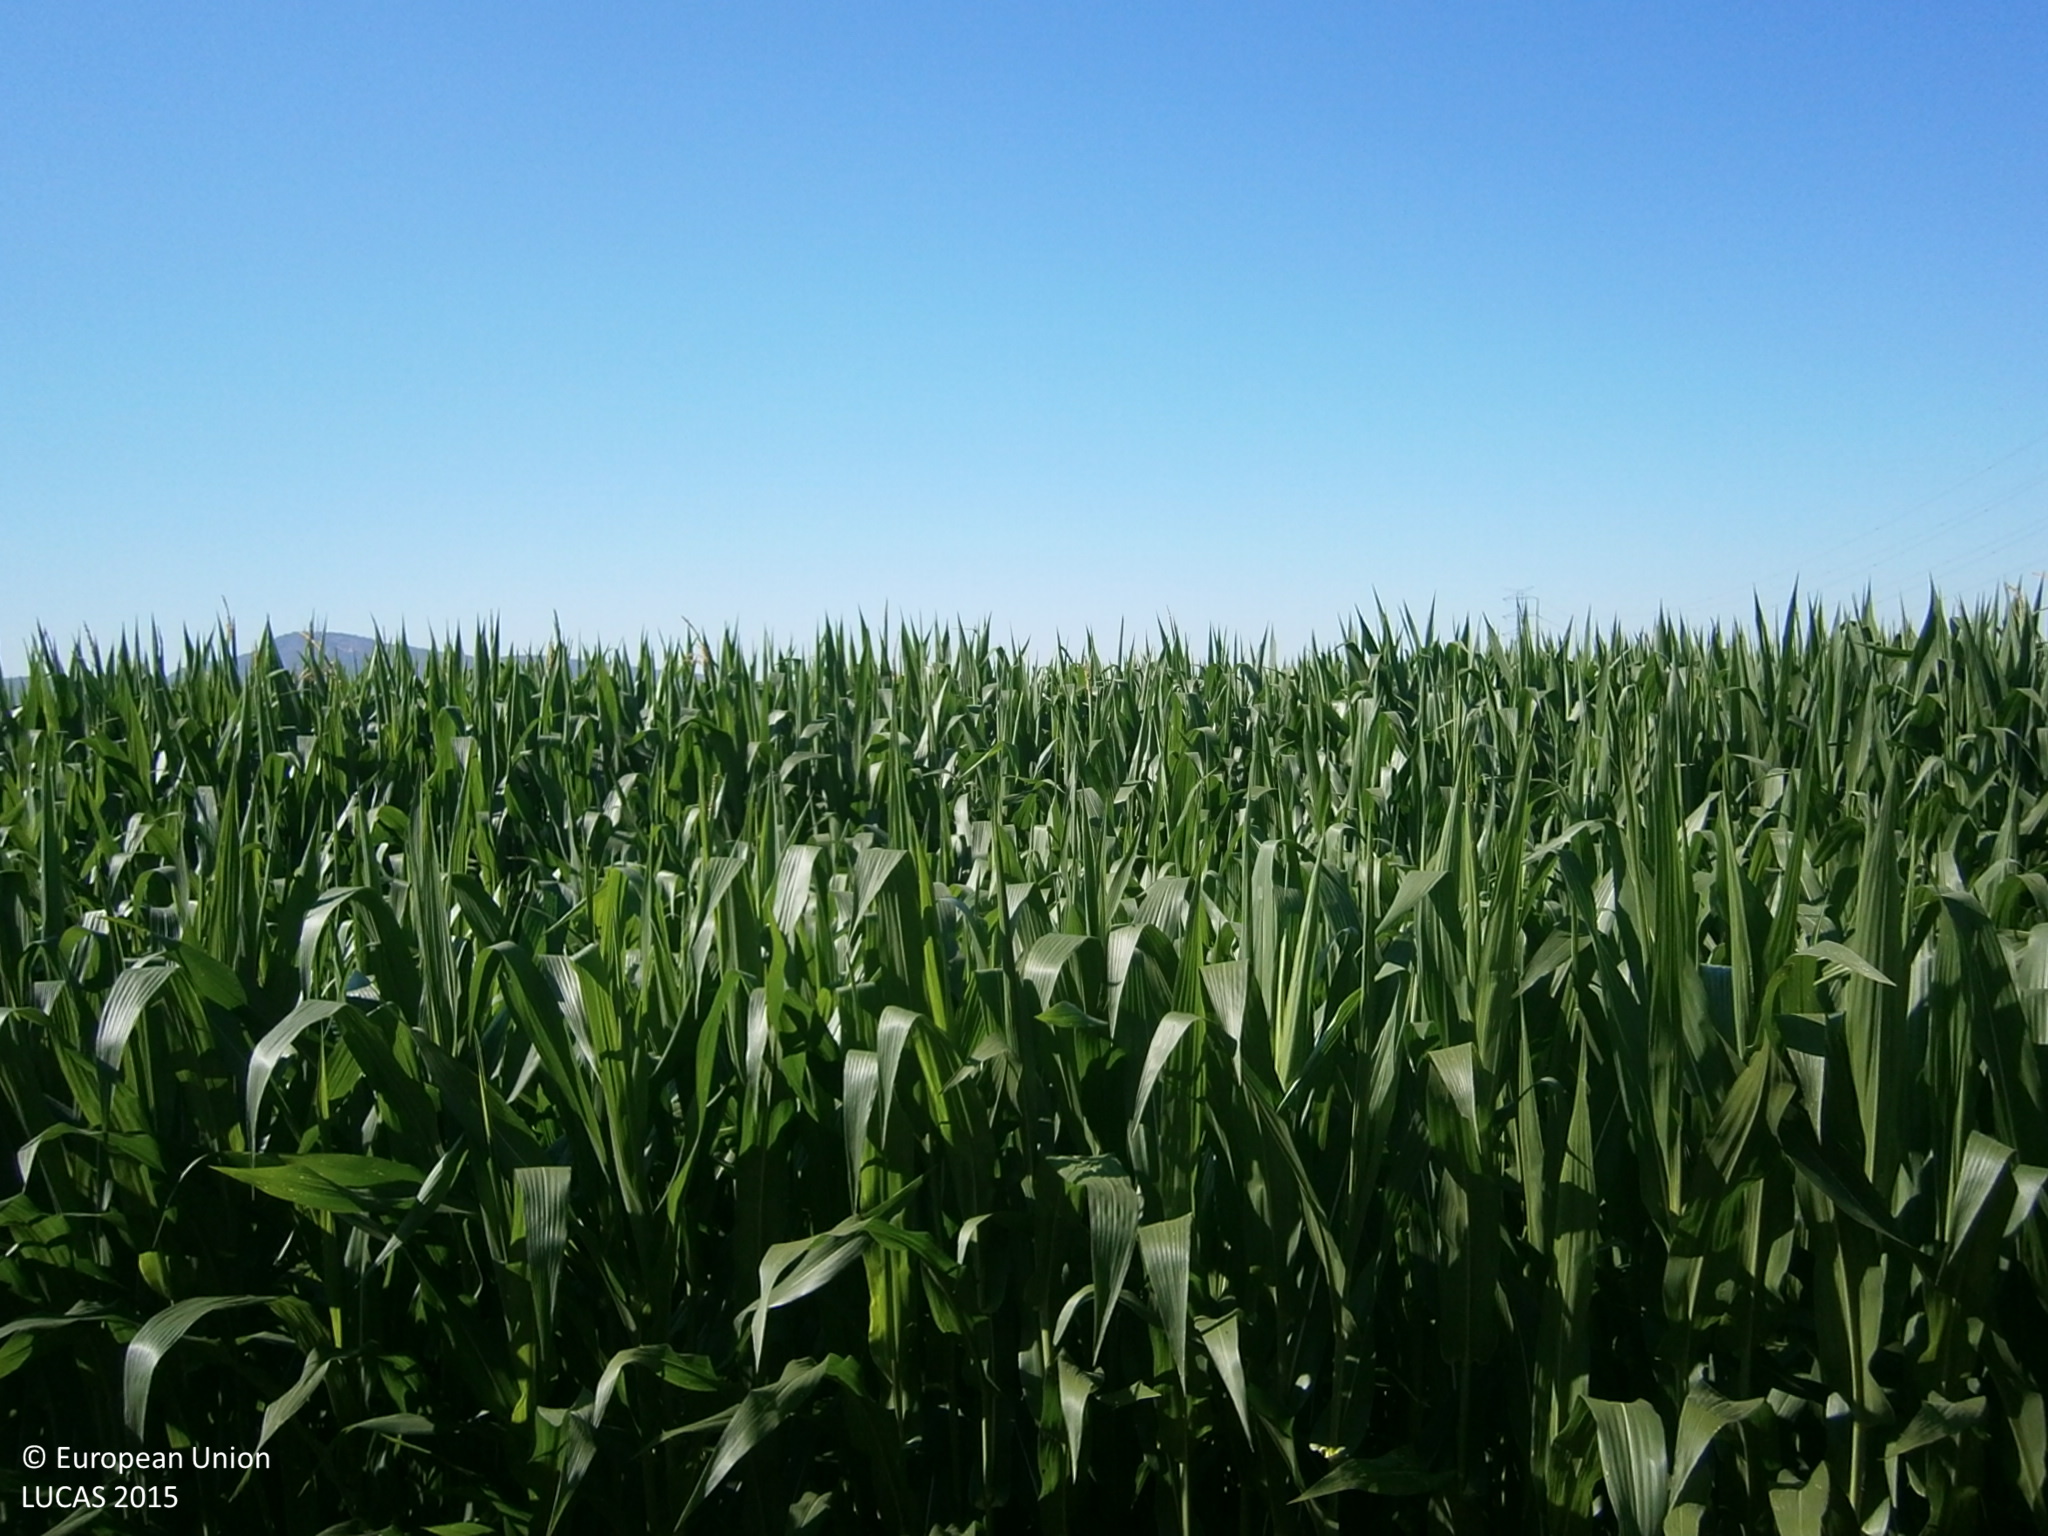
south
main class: Cropland
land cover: Maize
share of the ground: > 75 %
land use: Agriculture (excluding fallow land and kitchen gardens)
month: June
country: ES
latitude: 38.9057
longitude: -6.4456
